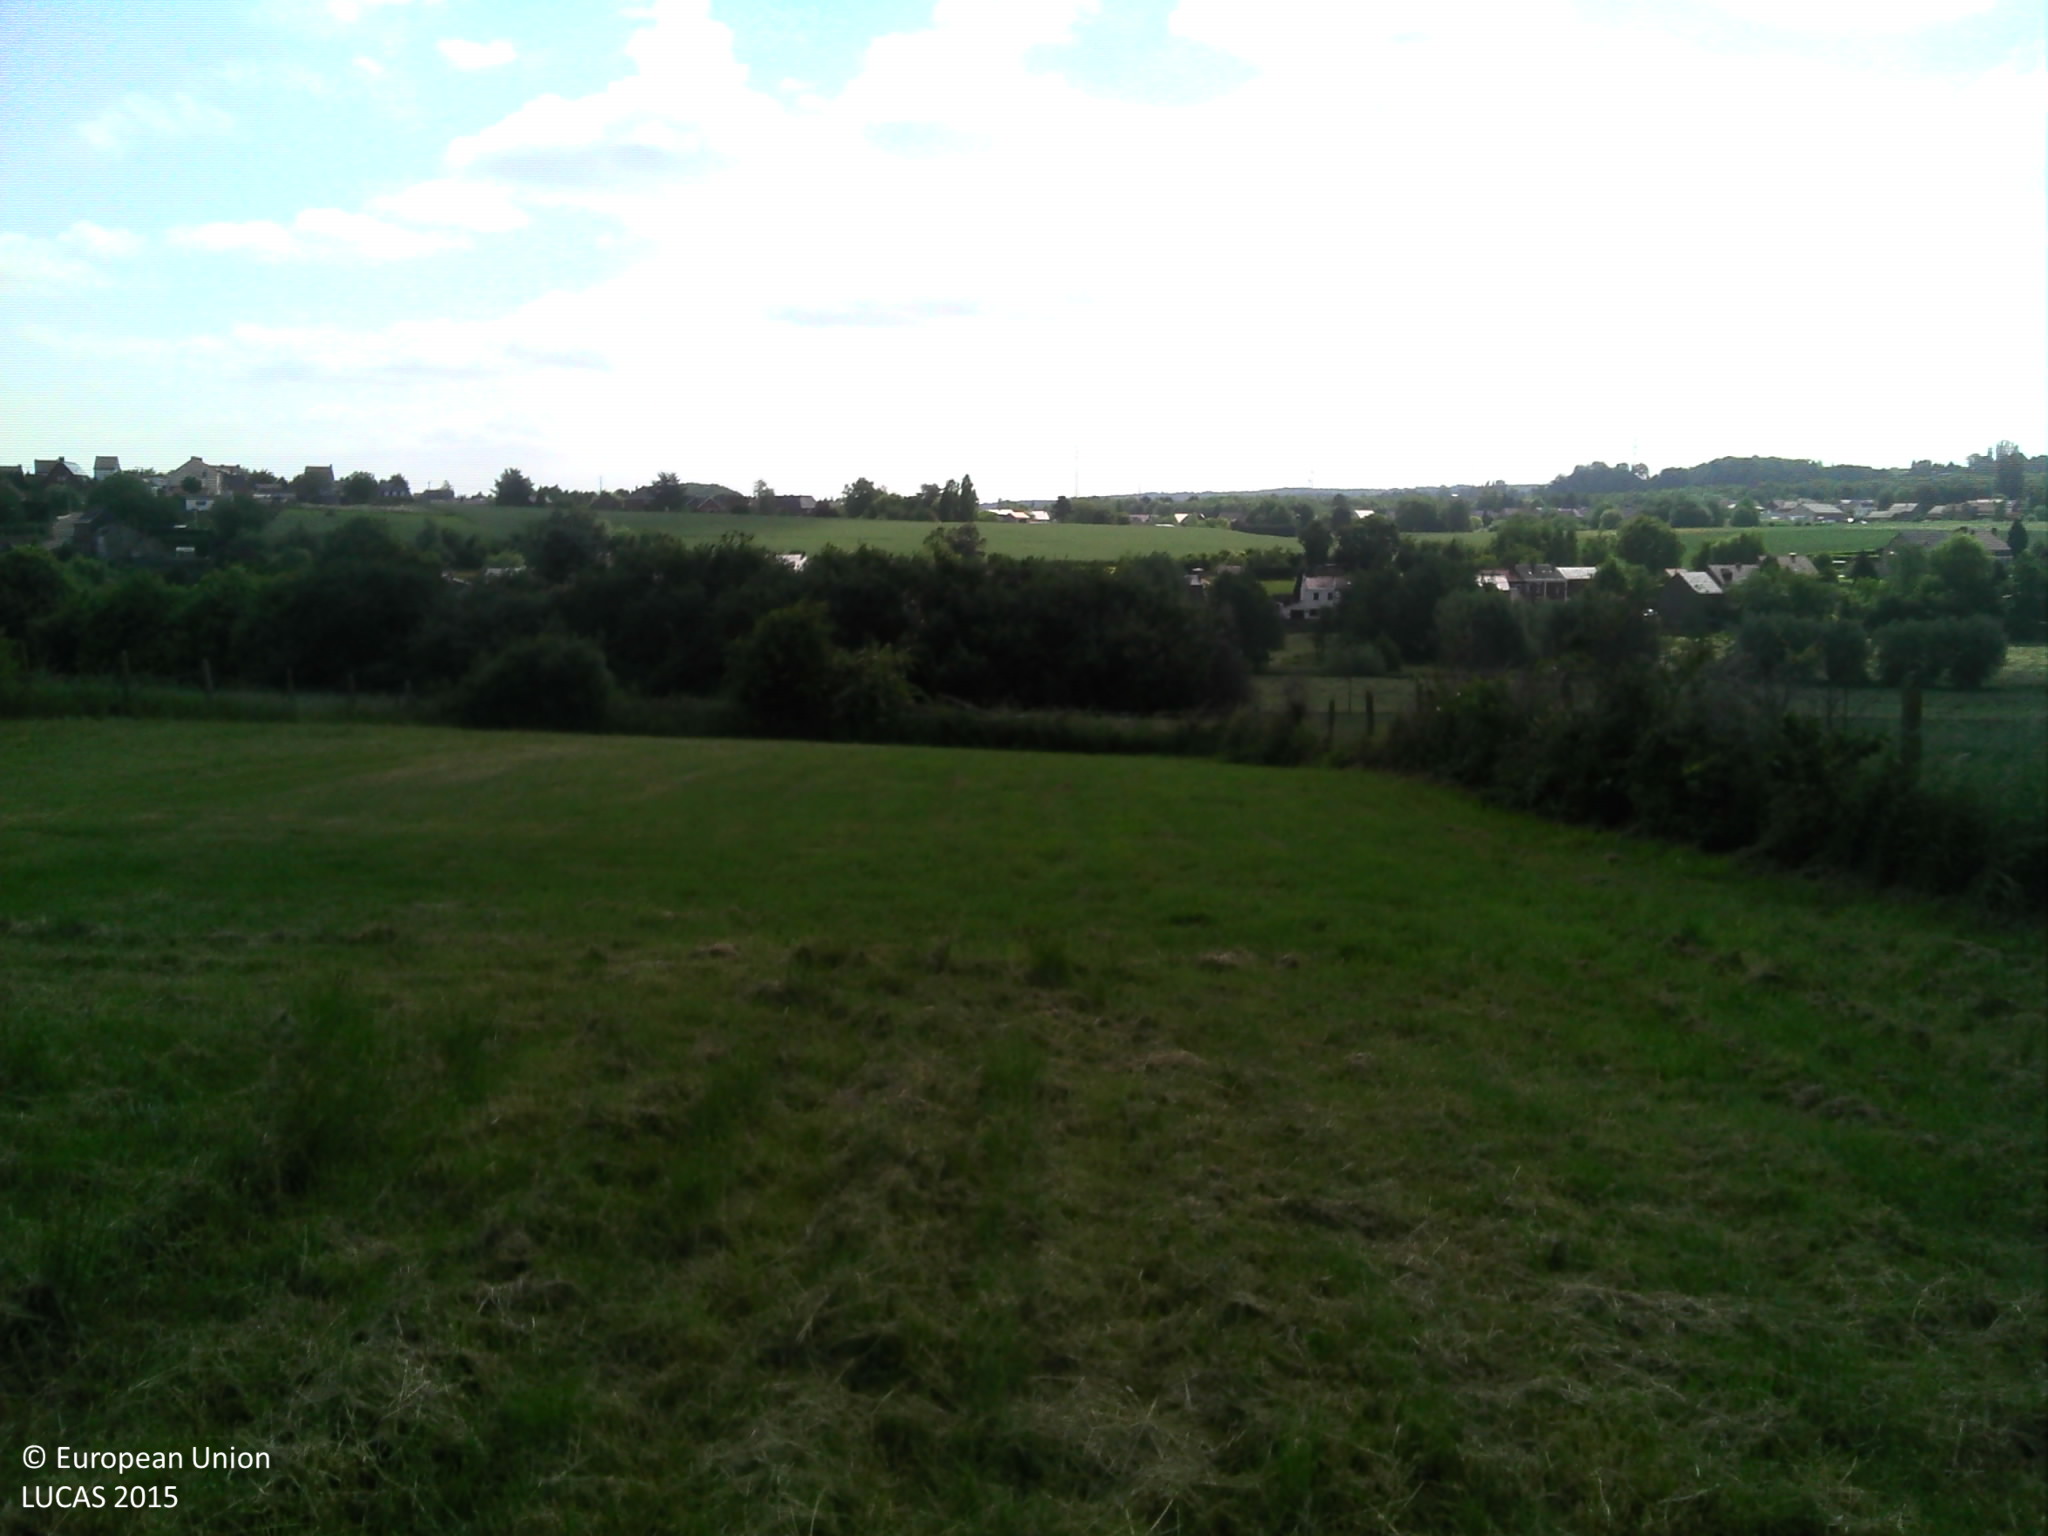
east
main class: Grassland
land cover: Grassland without tree/shrub cover
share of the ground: > 75 %
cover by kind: herbaceous plants 100 %
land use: Residential
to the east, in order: Grassland without tree/shrub cover; Fences; Common wheat; Broadleaved woodland; Common wheat; Tracks; Grass margins; Electric lines; Fences; Grassland without tree/shrub cover
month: June
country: BE
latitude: 50.4363
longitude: 4.6320
